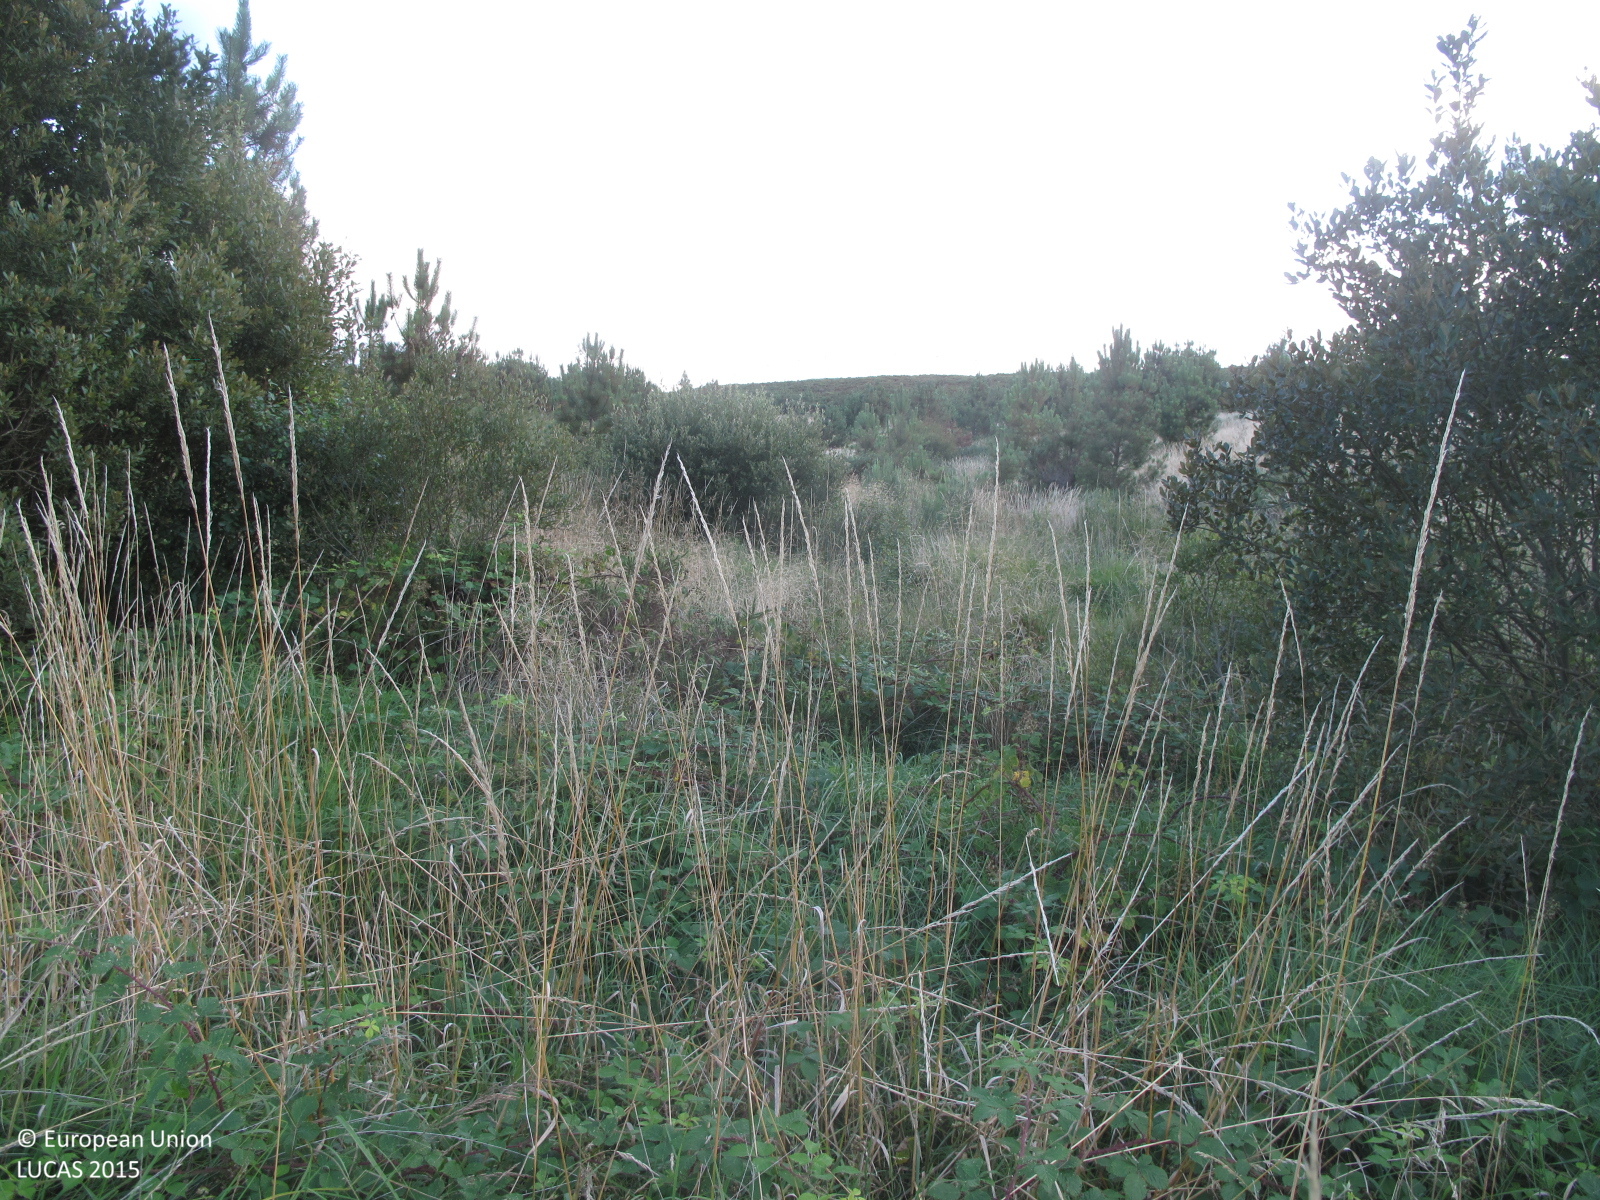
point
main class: Woodland
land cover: Pine dominated mixed woodland
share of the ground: 10 - 25 %
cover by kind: herbaceous plants 60 %, shrubs 20 %, coniferous forest trees 15 %, broadleaved forest trees 5 %
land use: Semi-natural and natural areas not in use
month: July
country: ES
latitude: 42.8952
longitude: -9.0664
